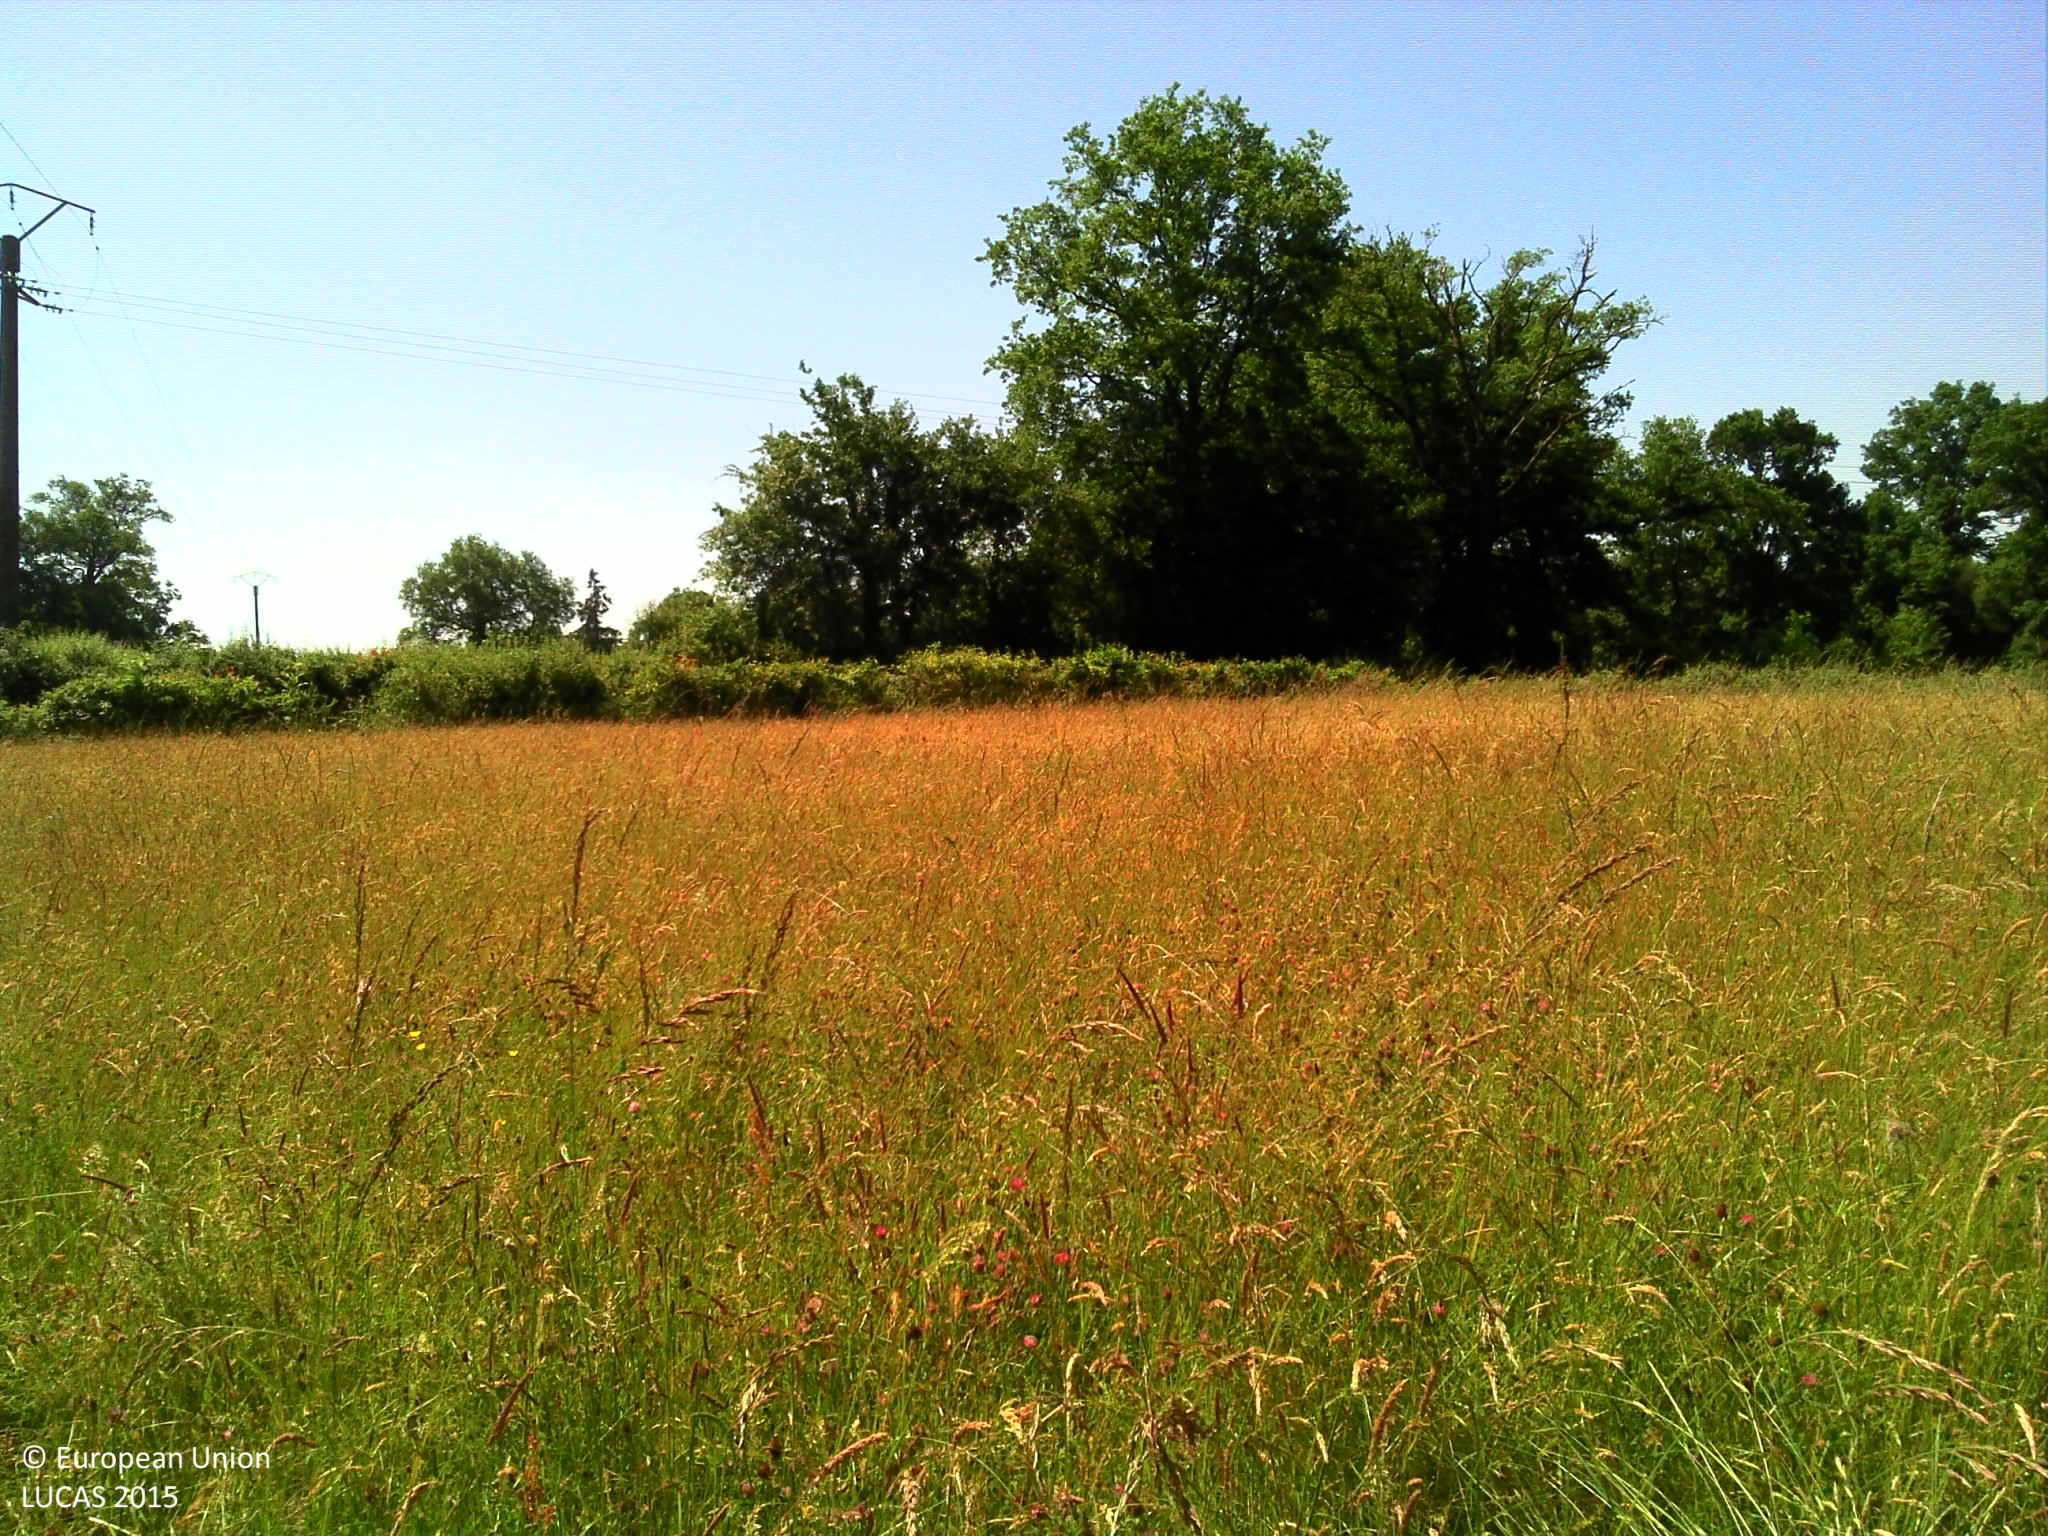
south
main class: Grassland
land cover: Grassland without tree/shrub cover
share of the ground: > 75 %
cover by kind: herbaceous plants 100 %
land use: Agriculture (excluding fallow land and kitchen gardens)
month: June
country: FR
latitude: 46.0310
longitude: 0.6448
